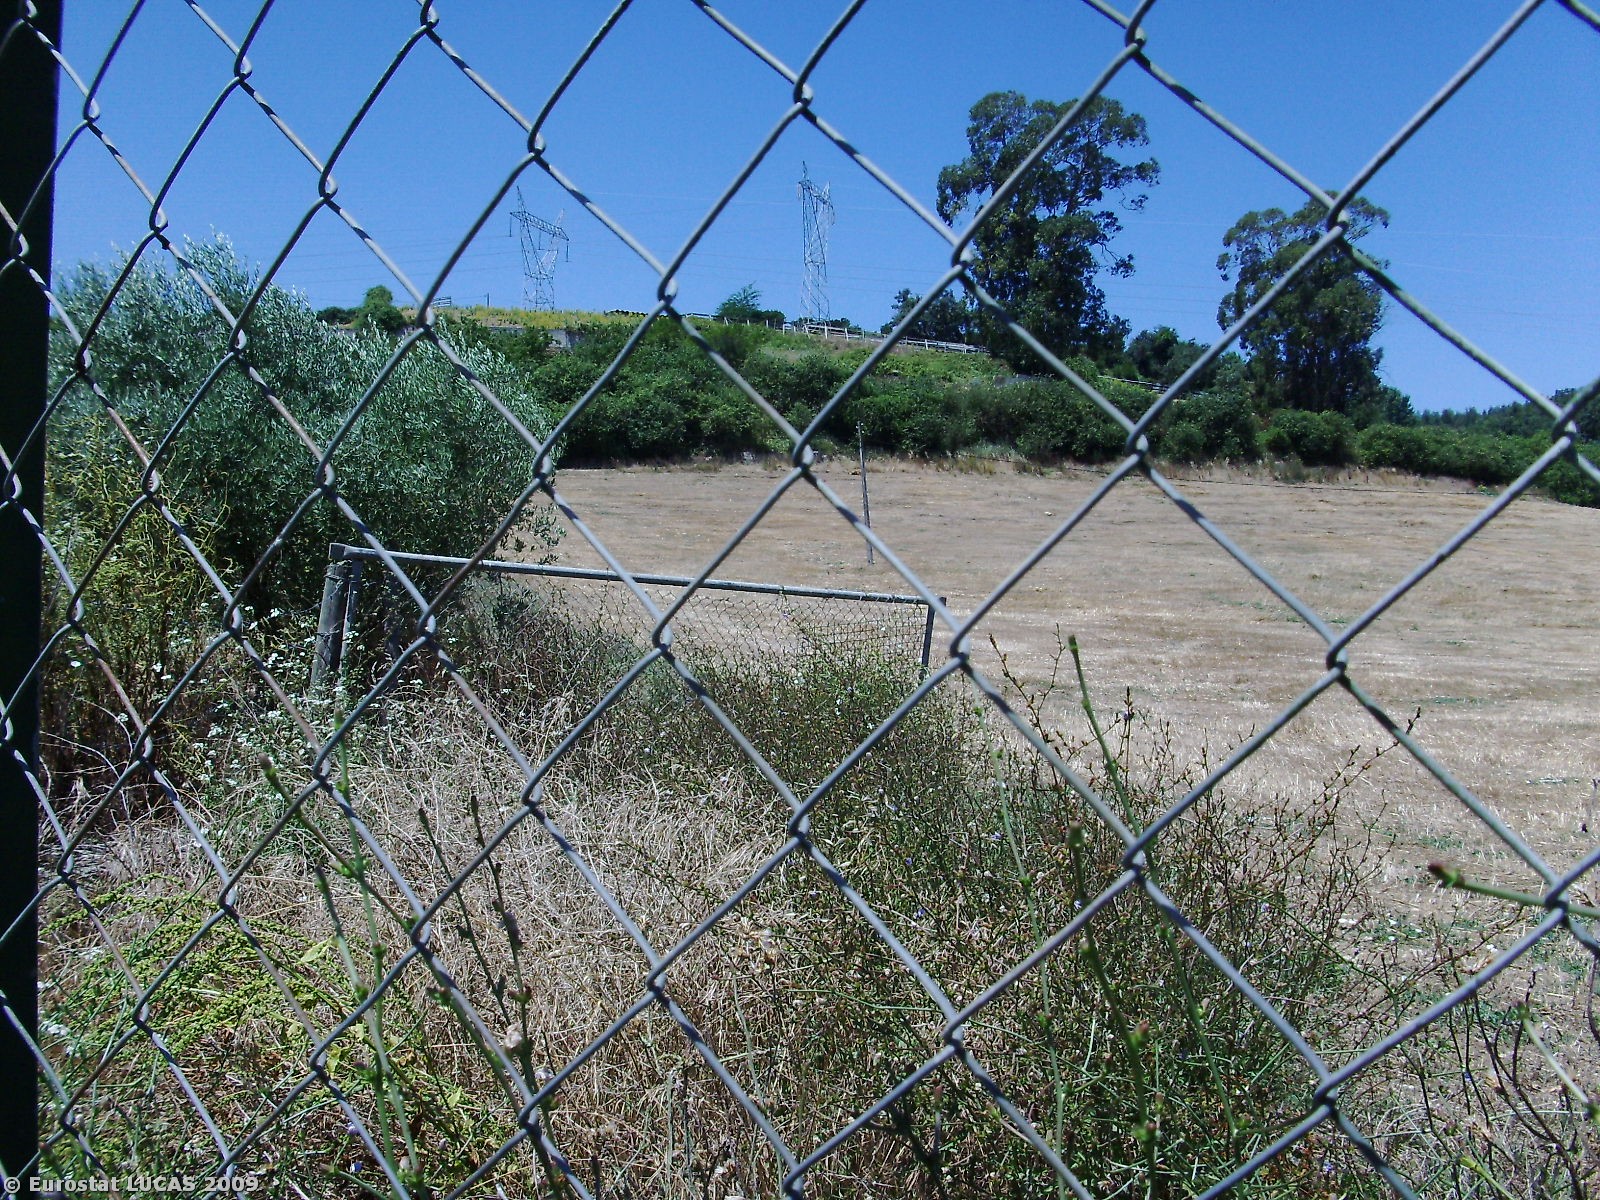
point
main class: Grassland
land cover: Grassland without tree/shrub cover
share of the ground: > 75 %
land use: Agriculture (excluding fallow land and kitchen gardens)
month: July
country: PT
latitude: 39.6114
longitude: -8.8247
